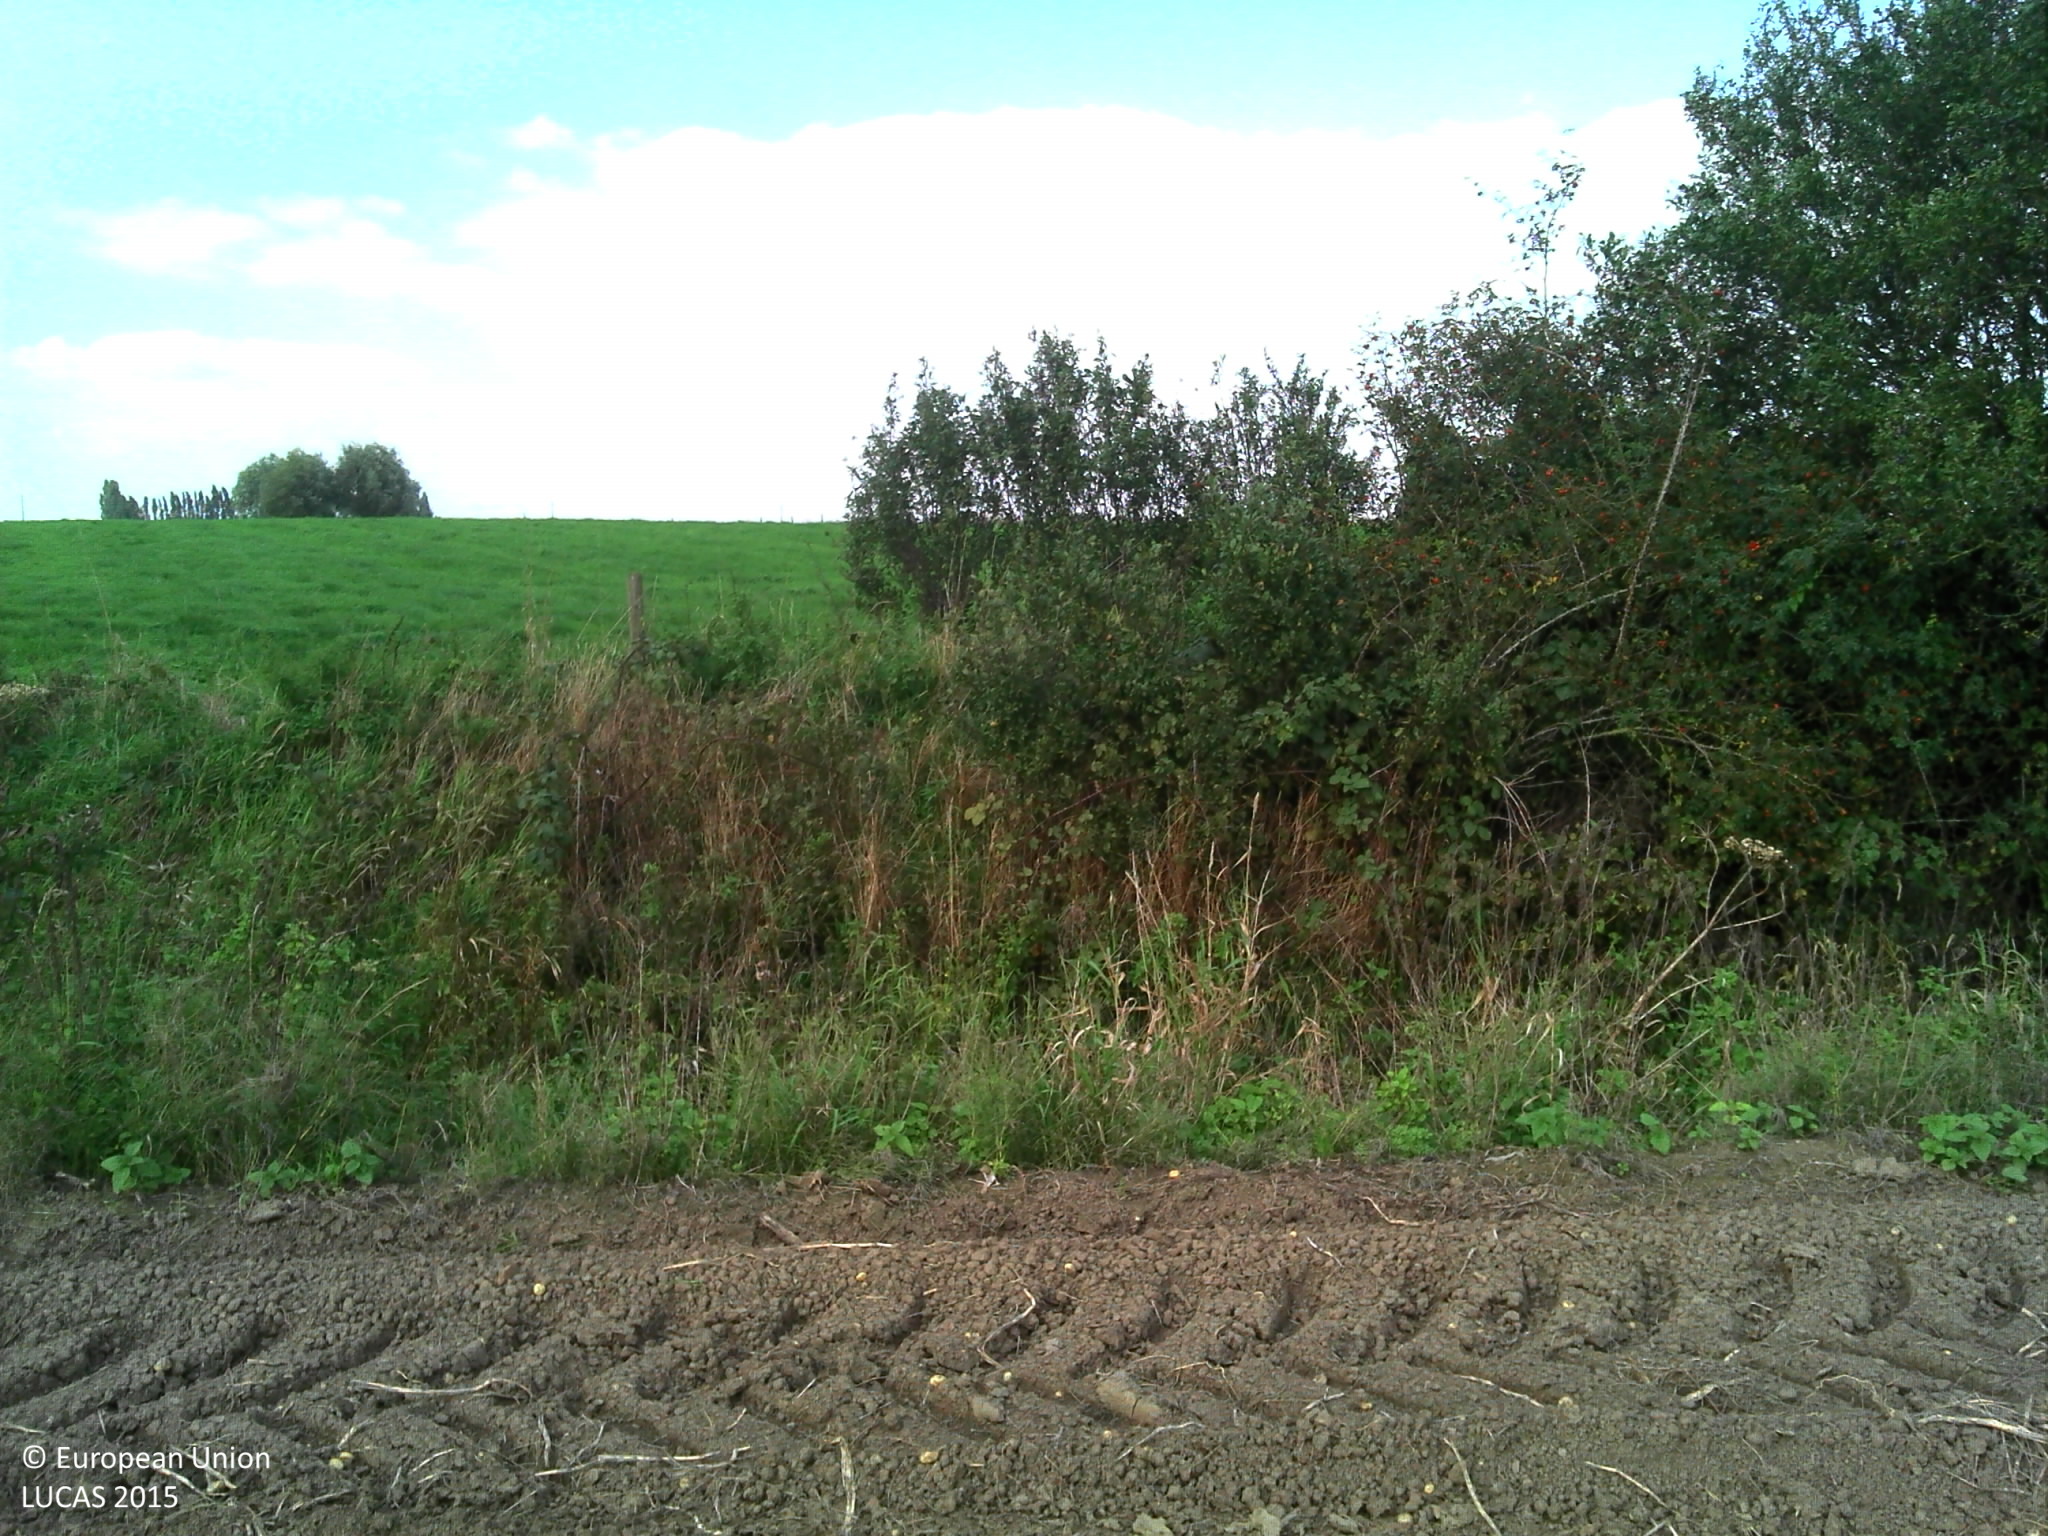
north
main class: Cropland
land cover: Potatoes
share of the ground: < 10 %
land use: Agriculture (excluding fallow land and kitchen gardens)
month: September
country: BE
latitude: 50.8923
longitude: 2.7523
